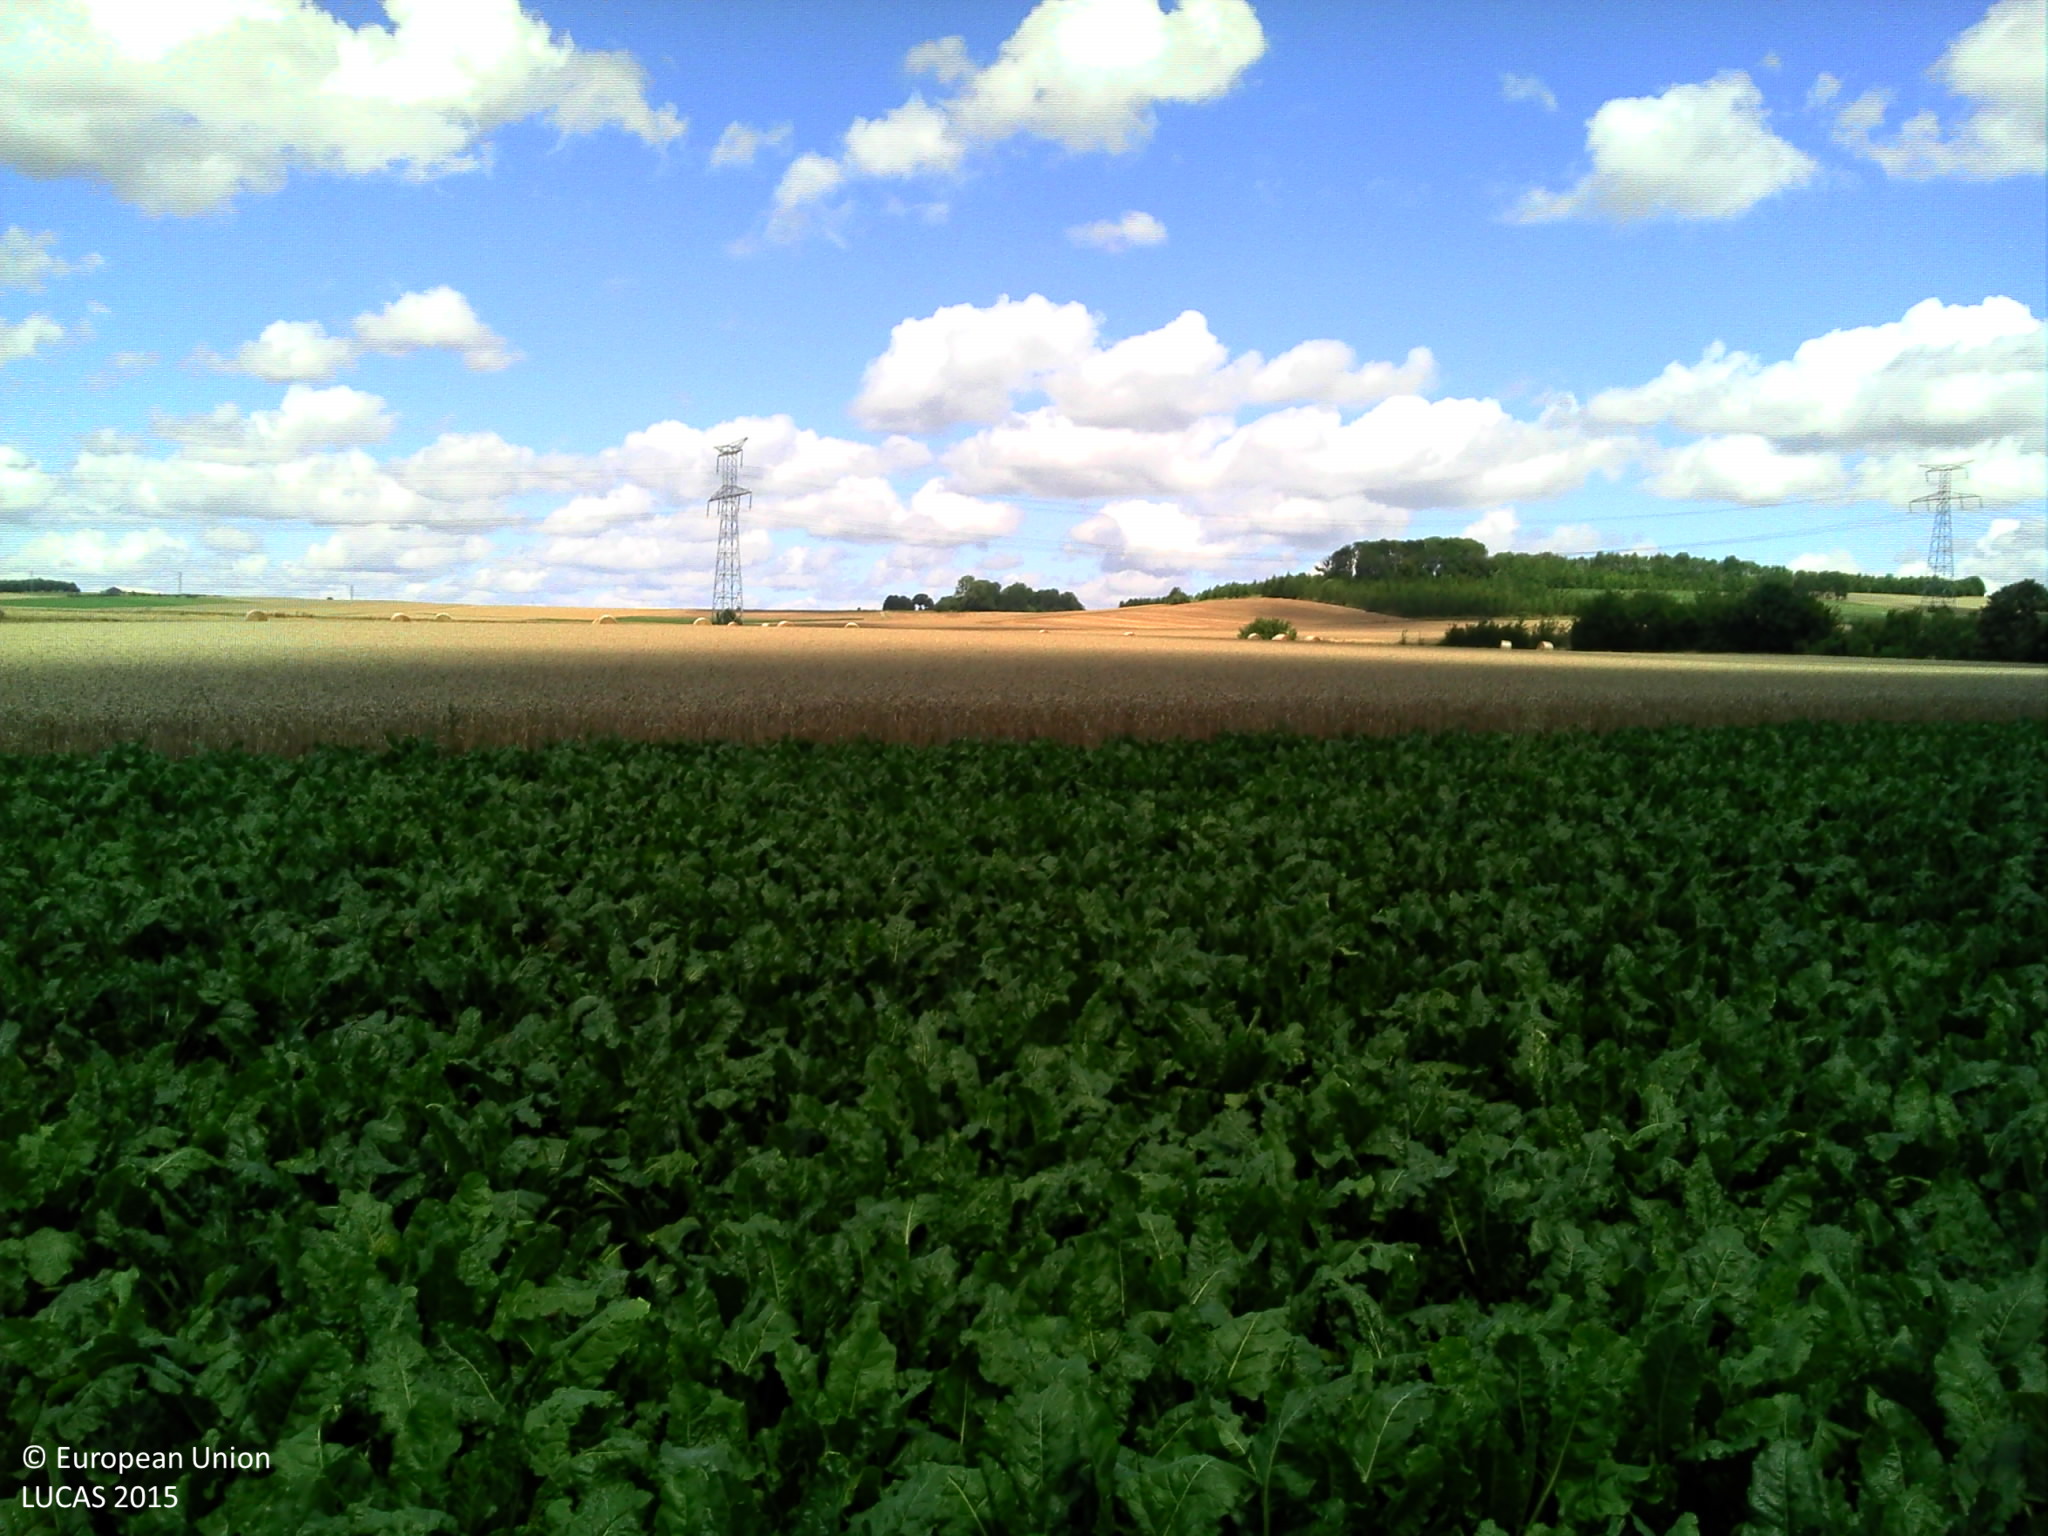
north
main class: Cropland
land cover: Sugar beet
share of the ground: > 75 %
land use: Agriculture (excluding fallow land and kitchen gardens)
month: July
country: FR
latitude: 50.0052
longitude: 2.4389
